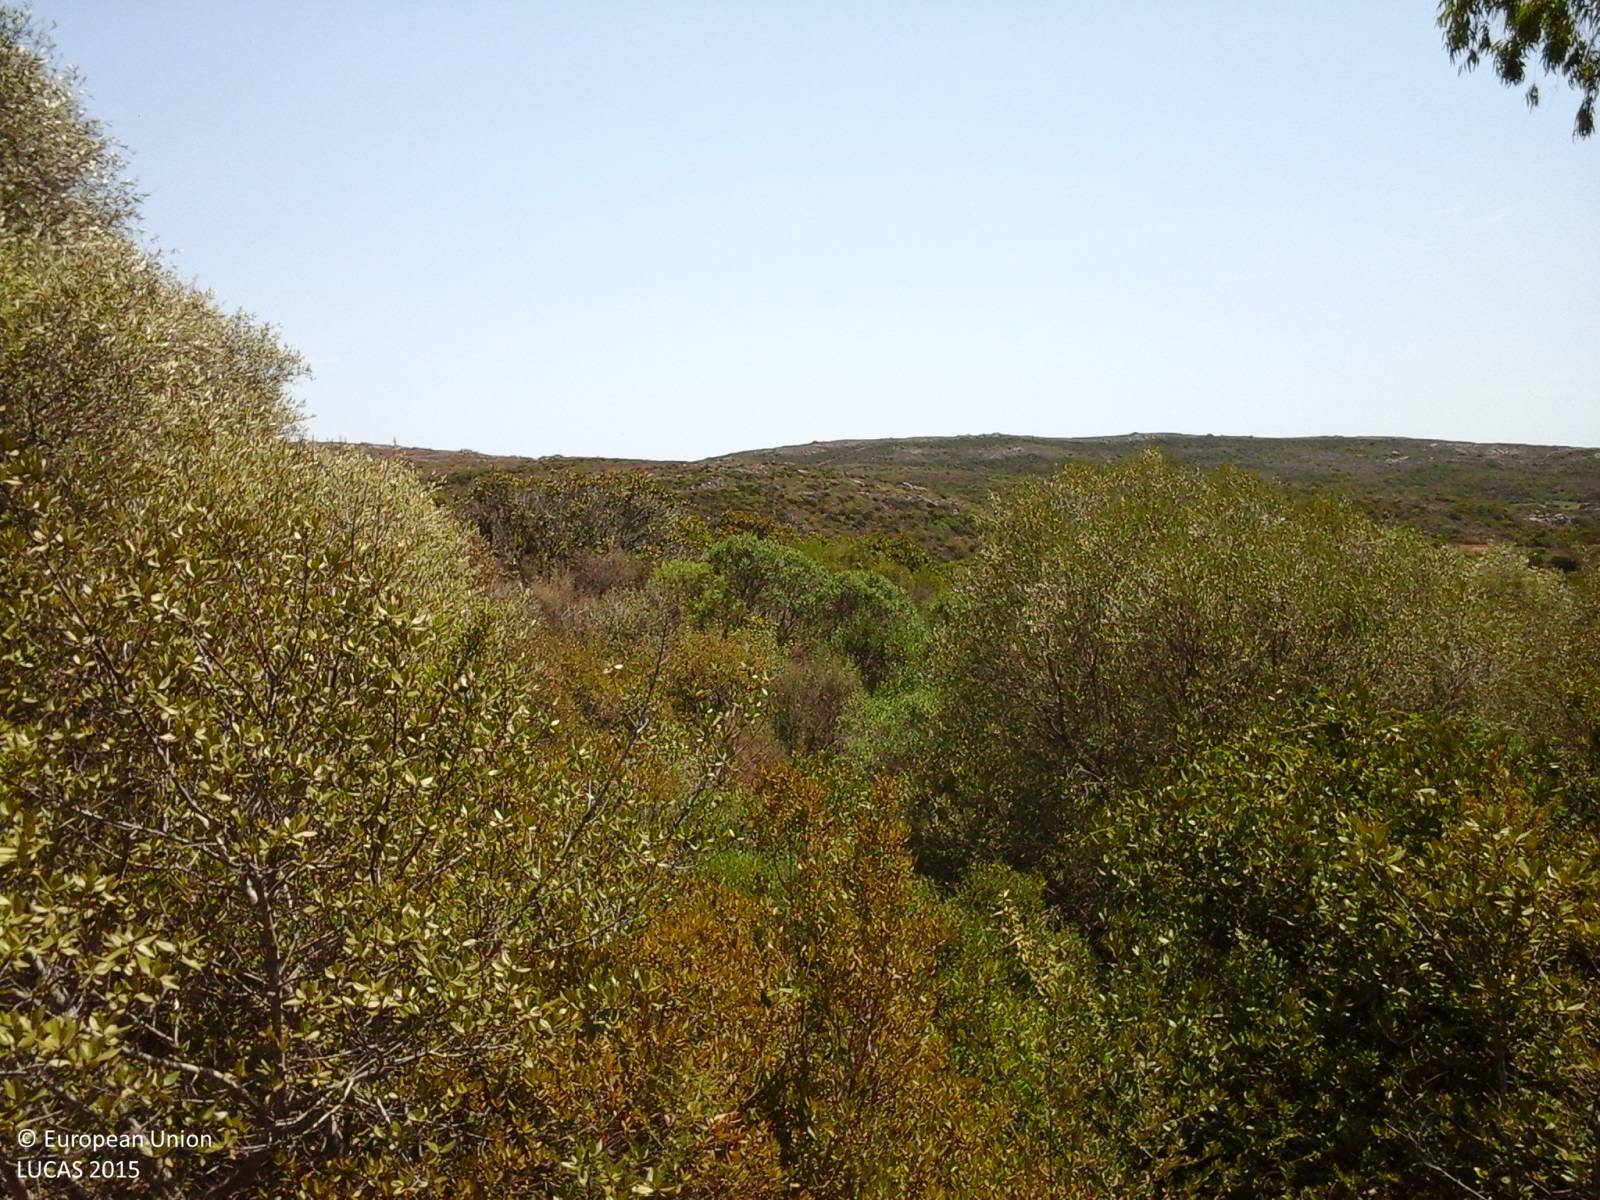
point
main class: Shrubland
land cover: Shrubland with sparse tree cover
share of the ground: > 75 %
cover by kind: shrubs 60 %, herbaceous plants 35 %, broadleaved forest trees 5 %
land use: Semi-natural and natural areas not in use
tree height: > 5 m
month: July
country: IT
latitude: 41.2414
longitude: 9.2278
